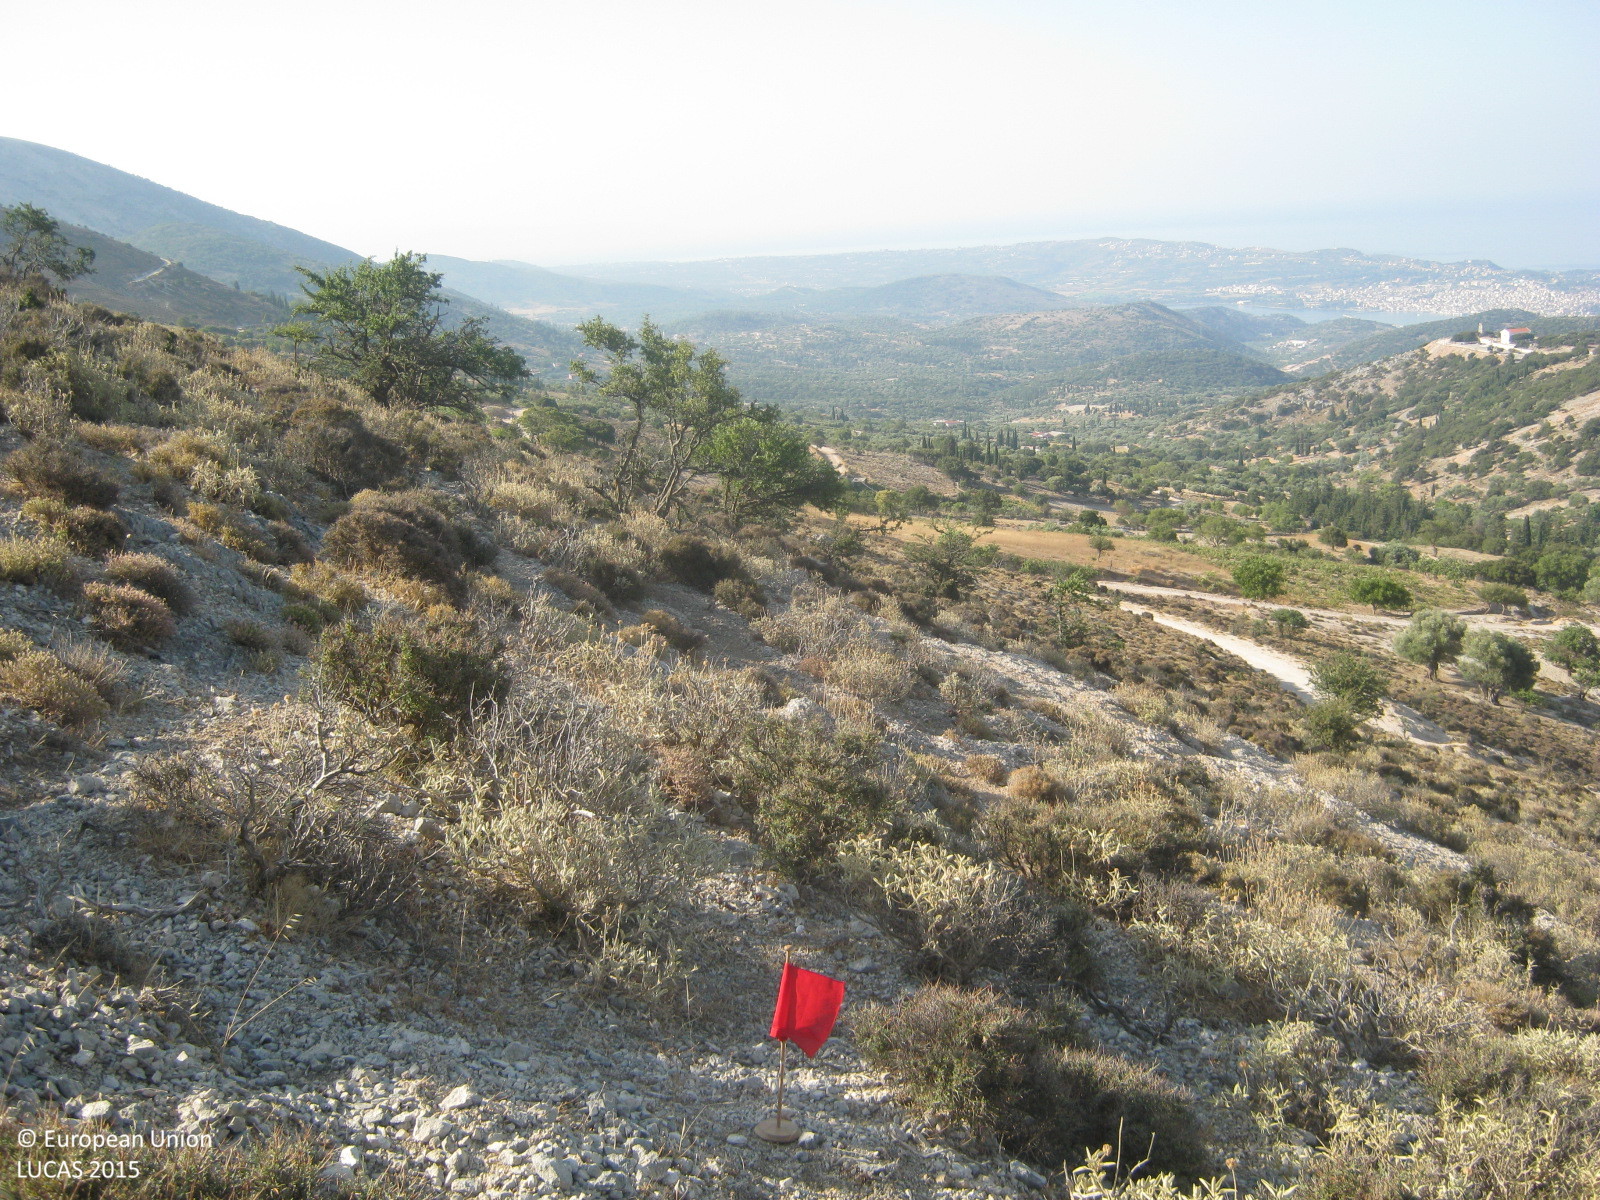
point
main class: Shrubland
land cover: Shrubland without tree cover
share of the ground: > 75 %
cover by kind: shrubs 70 %, unconsolidated bare surface 20 %, herbaceous plants 10 %
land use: Agriculture (excluding fallow land and kitchen gardens)
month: August
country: GR
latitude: 38.2417
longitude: 20.5074
